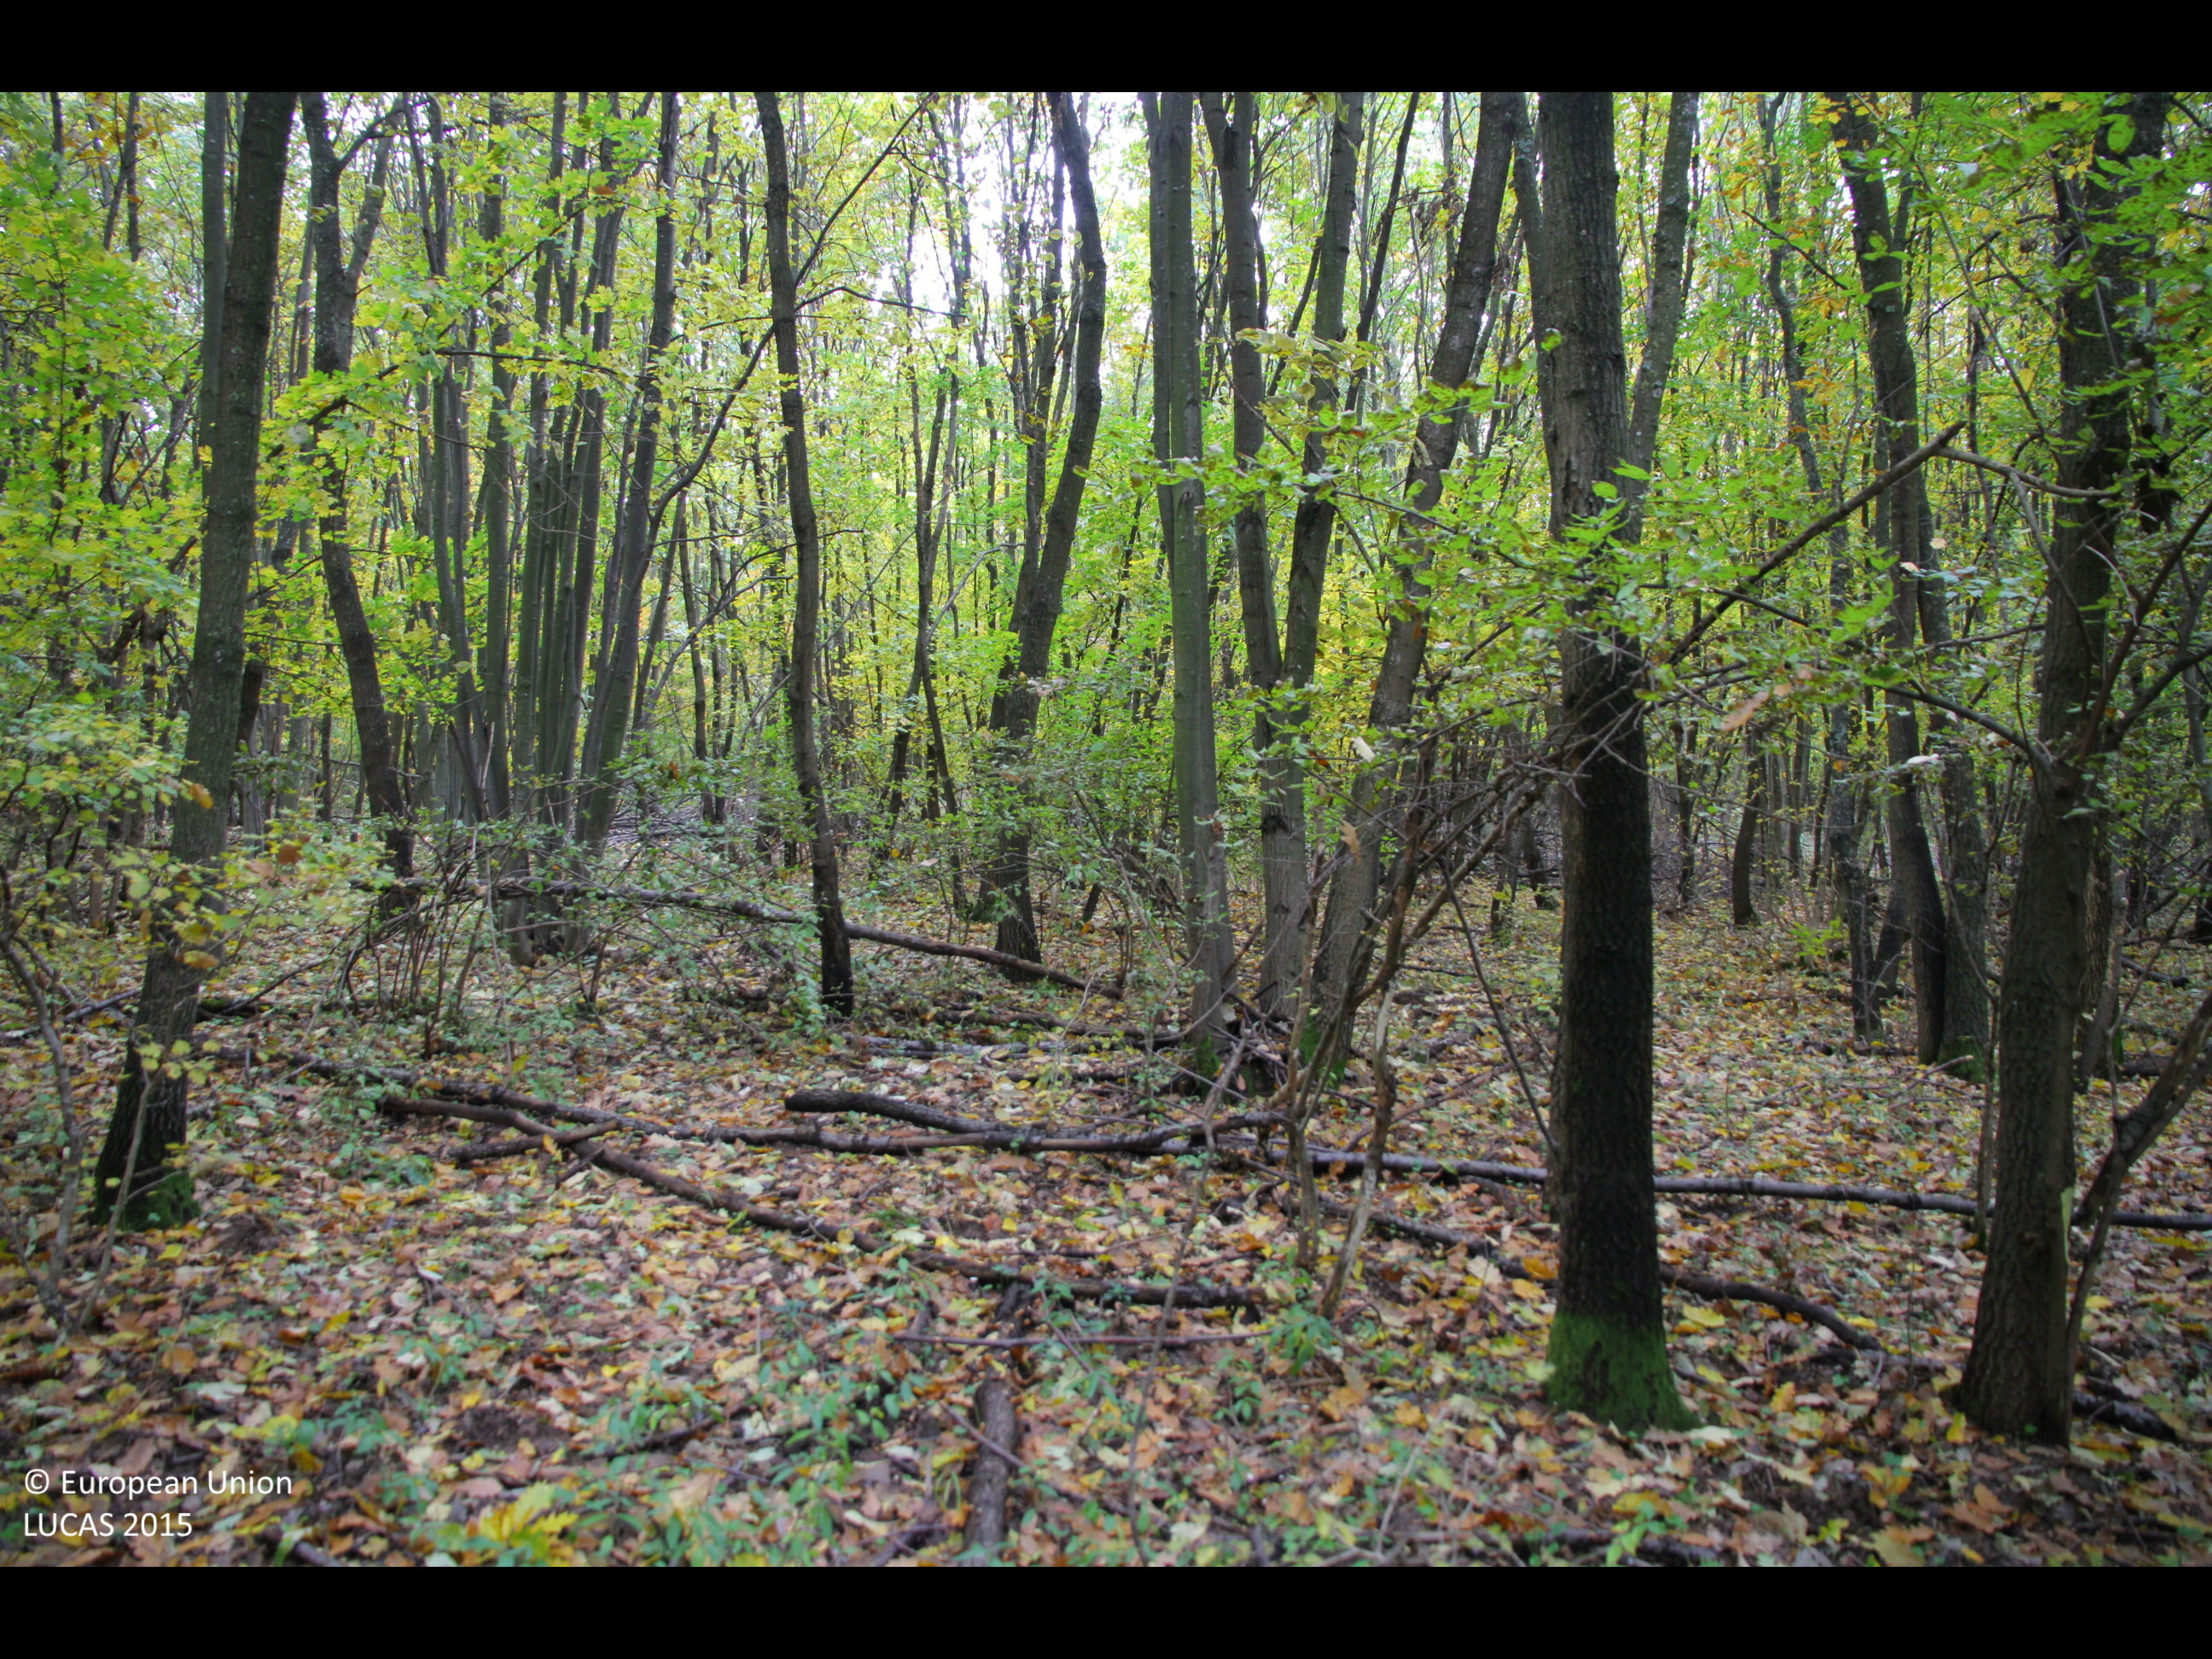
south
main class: Woodland
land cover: Broadleaved woodland
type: mesophytic deciduous forest
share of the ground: > 75 %
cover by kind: broadleaved forest trees 100 %
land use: Forestry
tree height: > 5 m
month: October
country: BG
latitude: 43.5164
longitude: 26.8260
